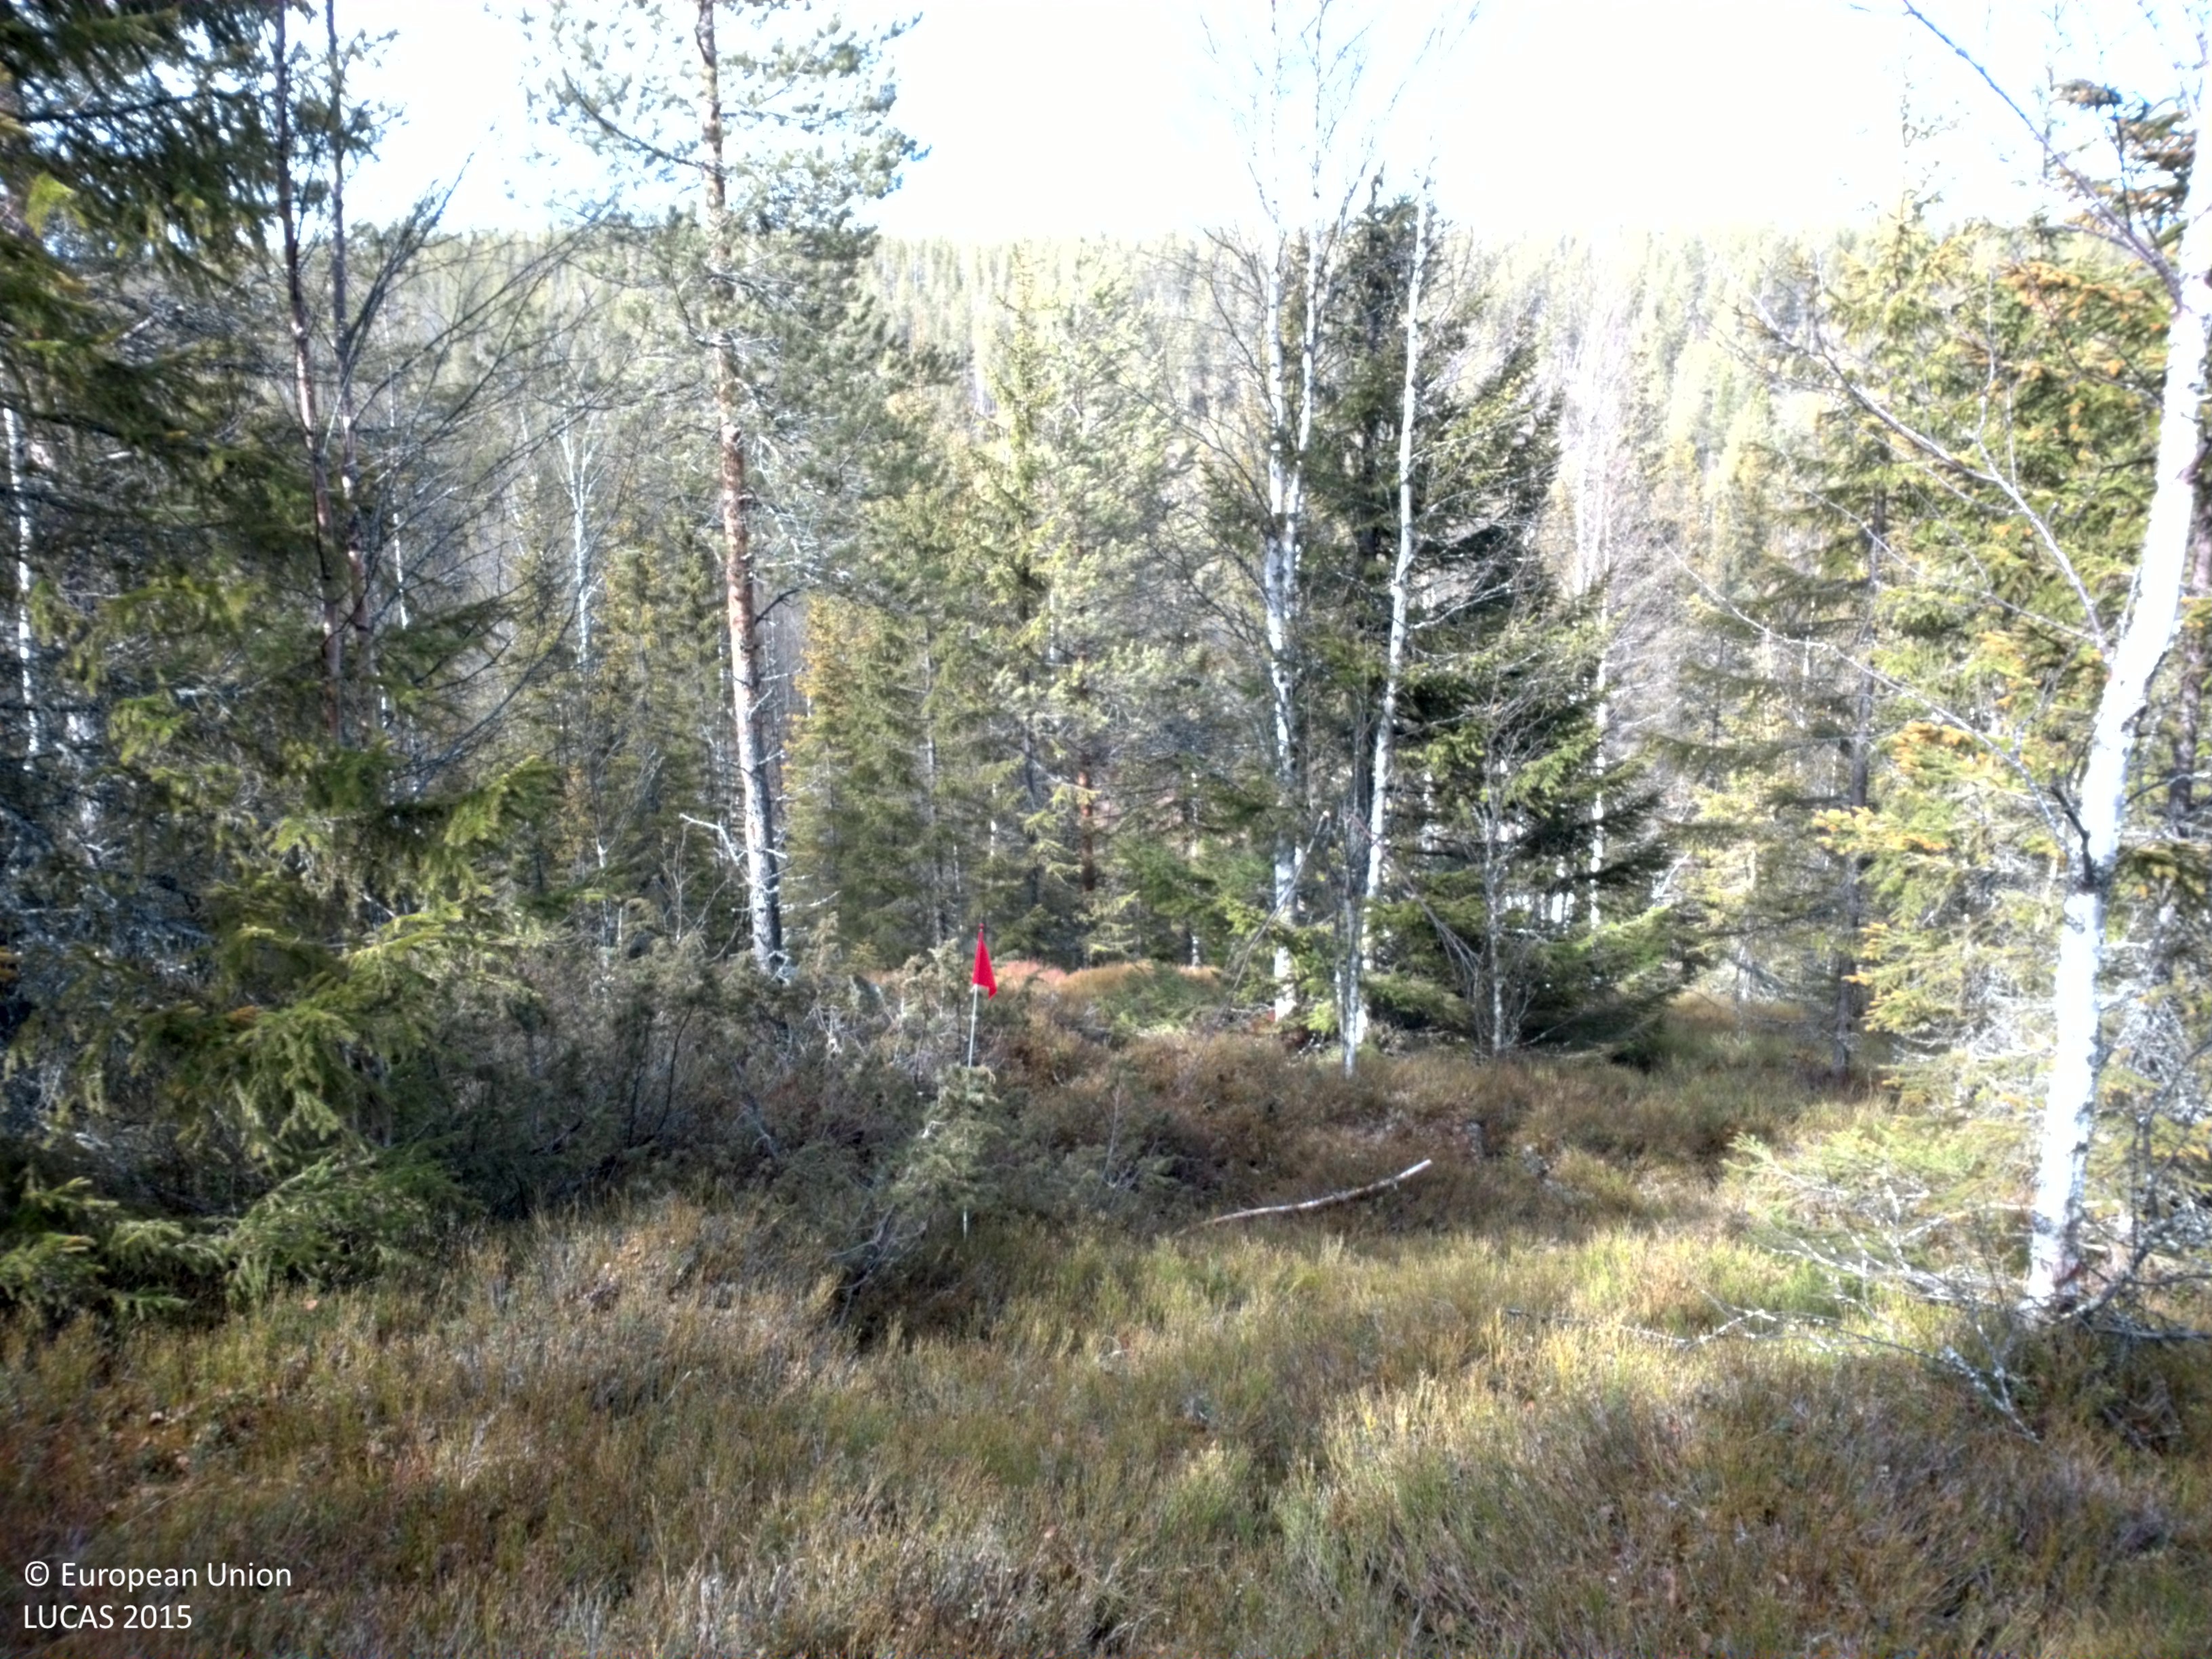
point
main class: Woodland
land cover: Spruce dominated coniferous woodland
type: boreal forest
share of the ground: 10 - 25 %
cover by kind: herbaceous plants 45 %, coniferous forest trees 25 %, shrubs 15 %, lichens and mosses 10 %, broadleaved forest trees 5 %
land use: Forestry
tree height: > 5 m
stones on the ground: 10 - 25 %
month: May
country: SE
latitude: 64.1952
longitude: 18.0203
